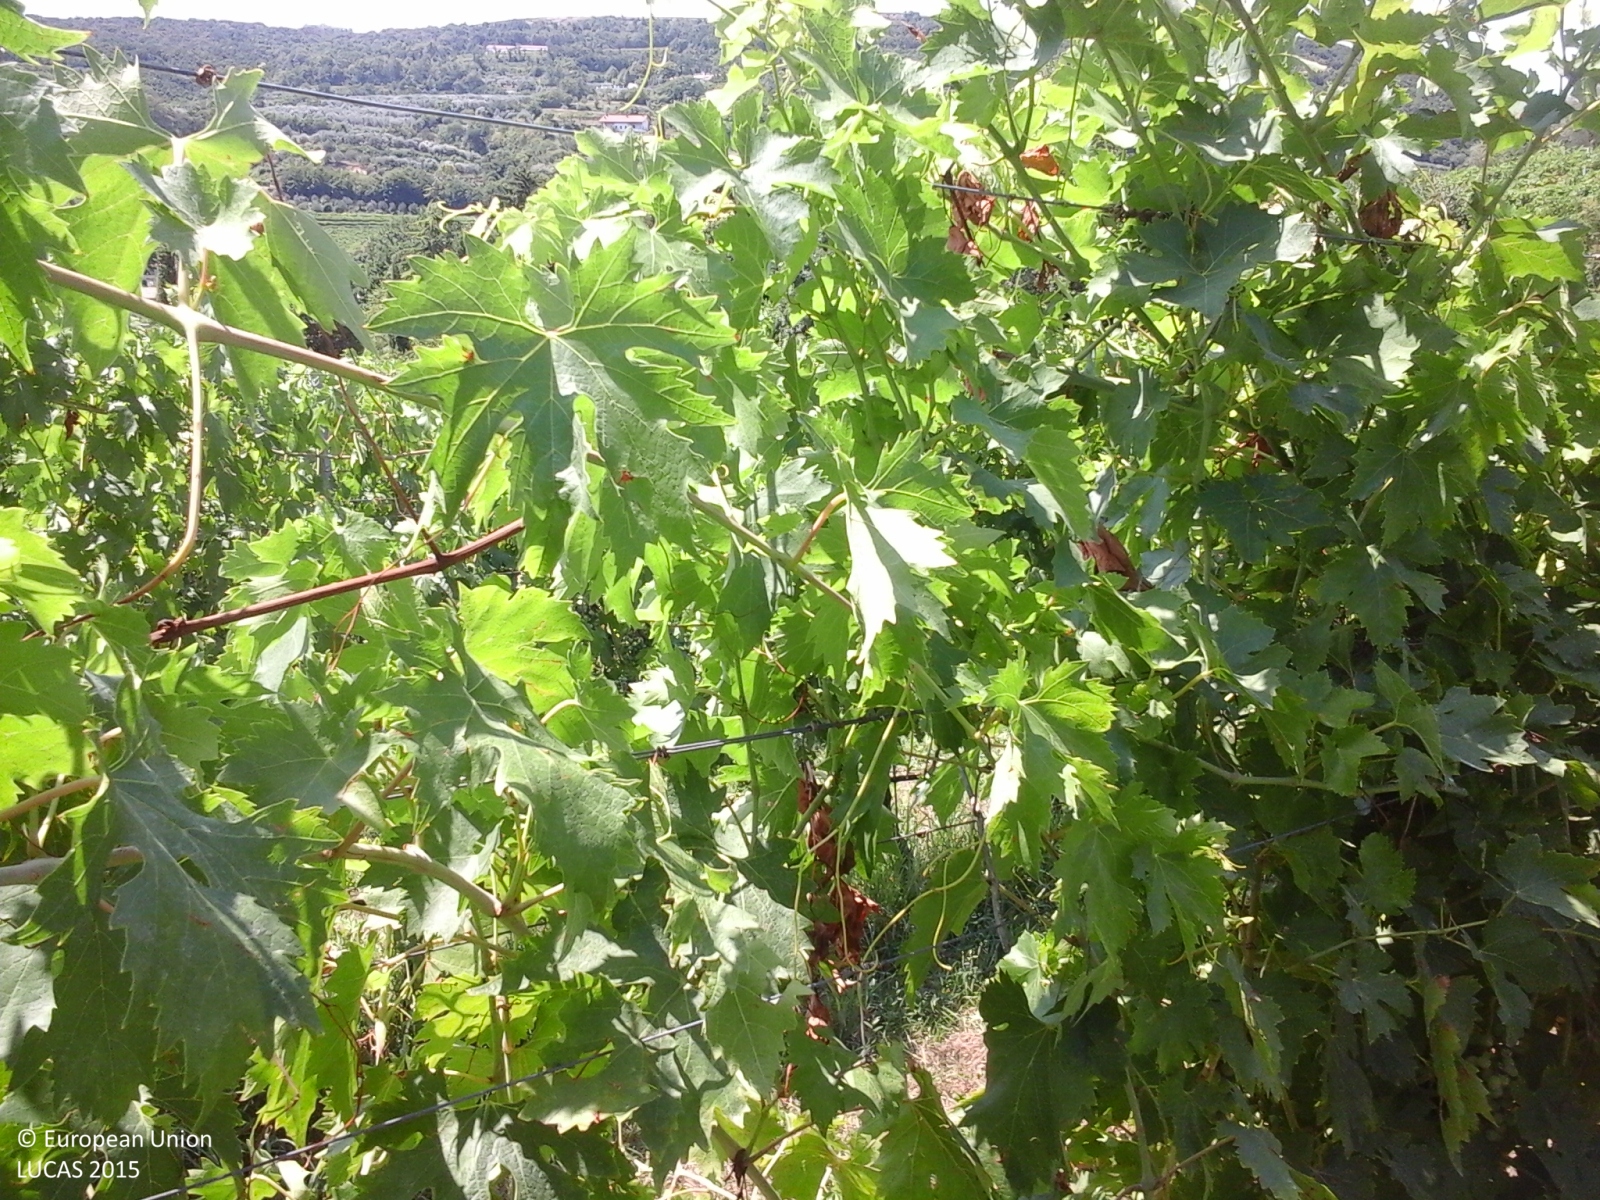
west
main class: Cropland
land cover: Vineyards
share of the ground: 25 - 50 %
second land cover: Grassland without tree/shrub cover
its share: > 75 %
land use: Agriculture (excluding fallow land and kitchen gardens)
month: July
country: IT
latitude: 45.4625
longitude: 11.1108
